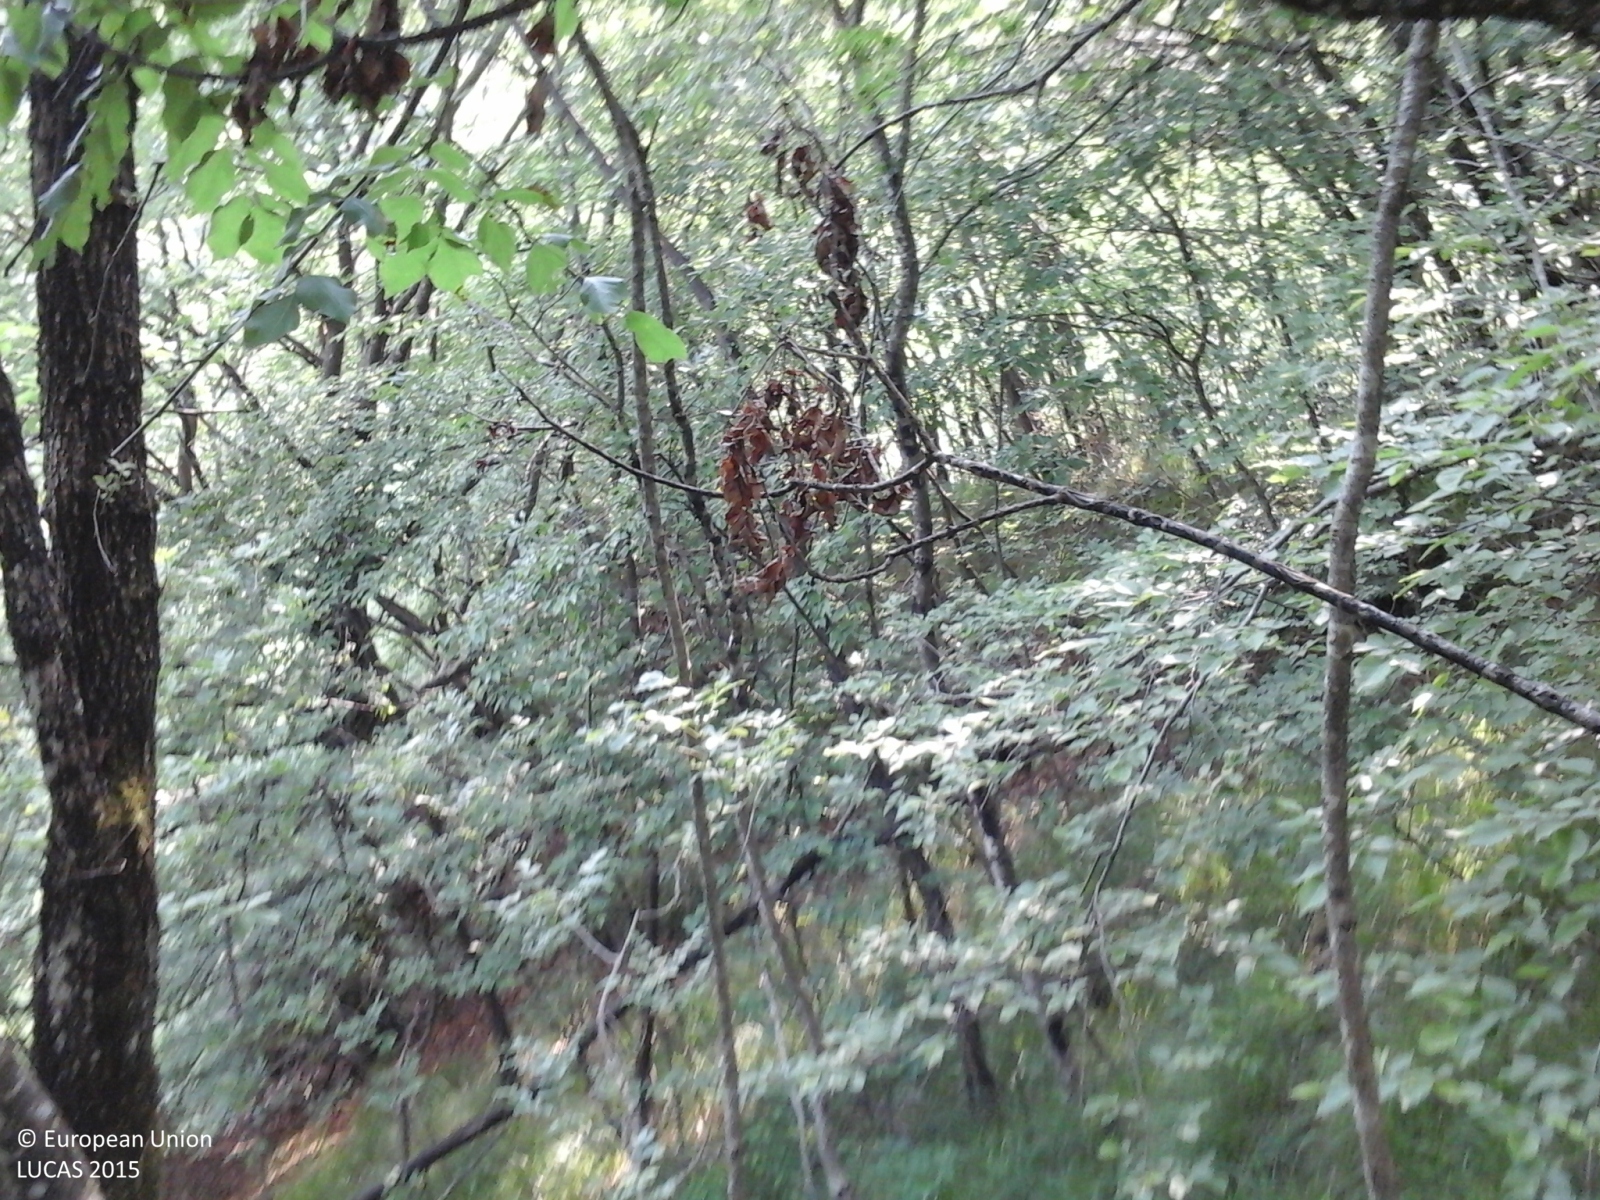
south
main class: Woodland
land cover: Broadleaved woodland
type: thermophilous deciduous forest
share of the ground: > 75 %
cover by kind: broadleaved forest trees 100 %
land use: Semi-natural and natural areas not in use
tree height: > 5 m
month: June
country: IT
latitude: 46.1808
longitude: 12.3678
